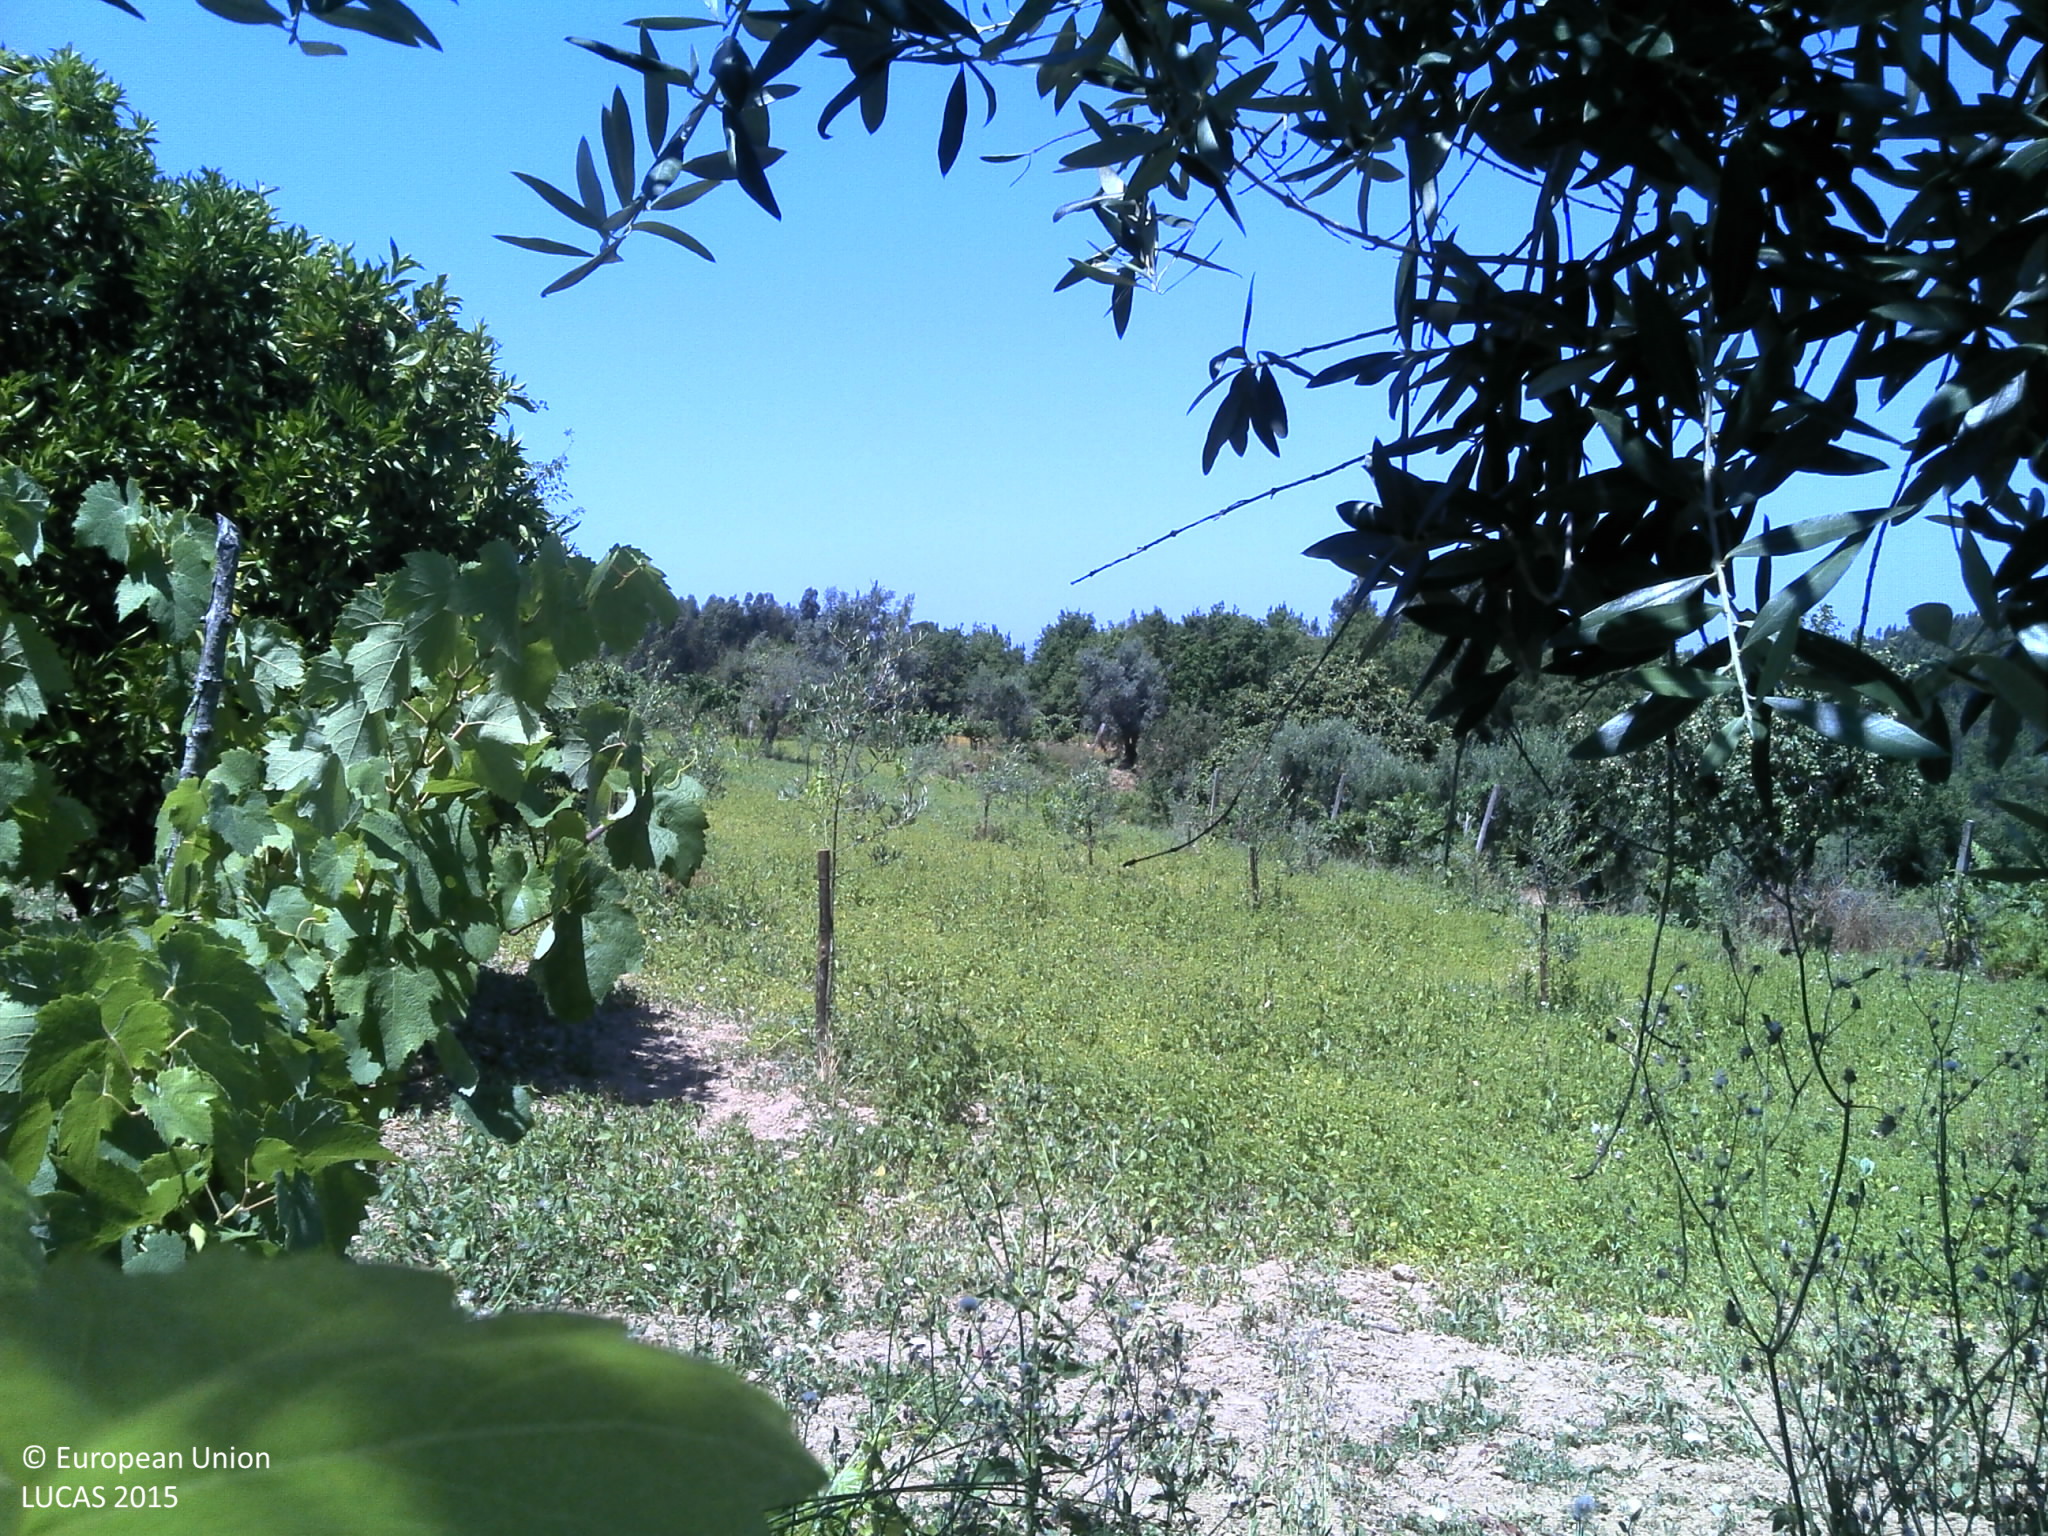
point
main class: Cropland
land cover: Olive groves
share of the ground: 10 - 25 %
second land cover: Grassland without tree/shrub cover
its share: 50 - 75 %
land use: Agriculture (excluding fallow land and kitchen gardens)
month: July
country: PT
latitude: 40.3250
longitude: -8.1919
